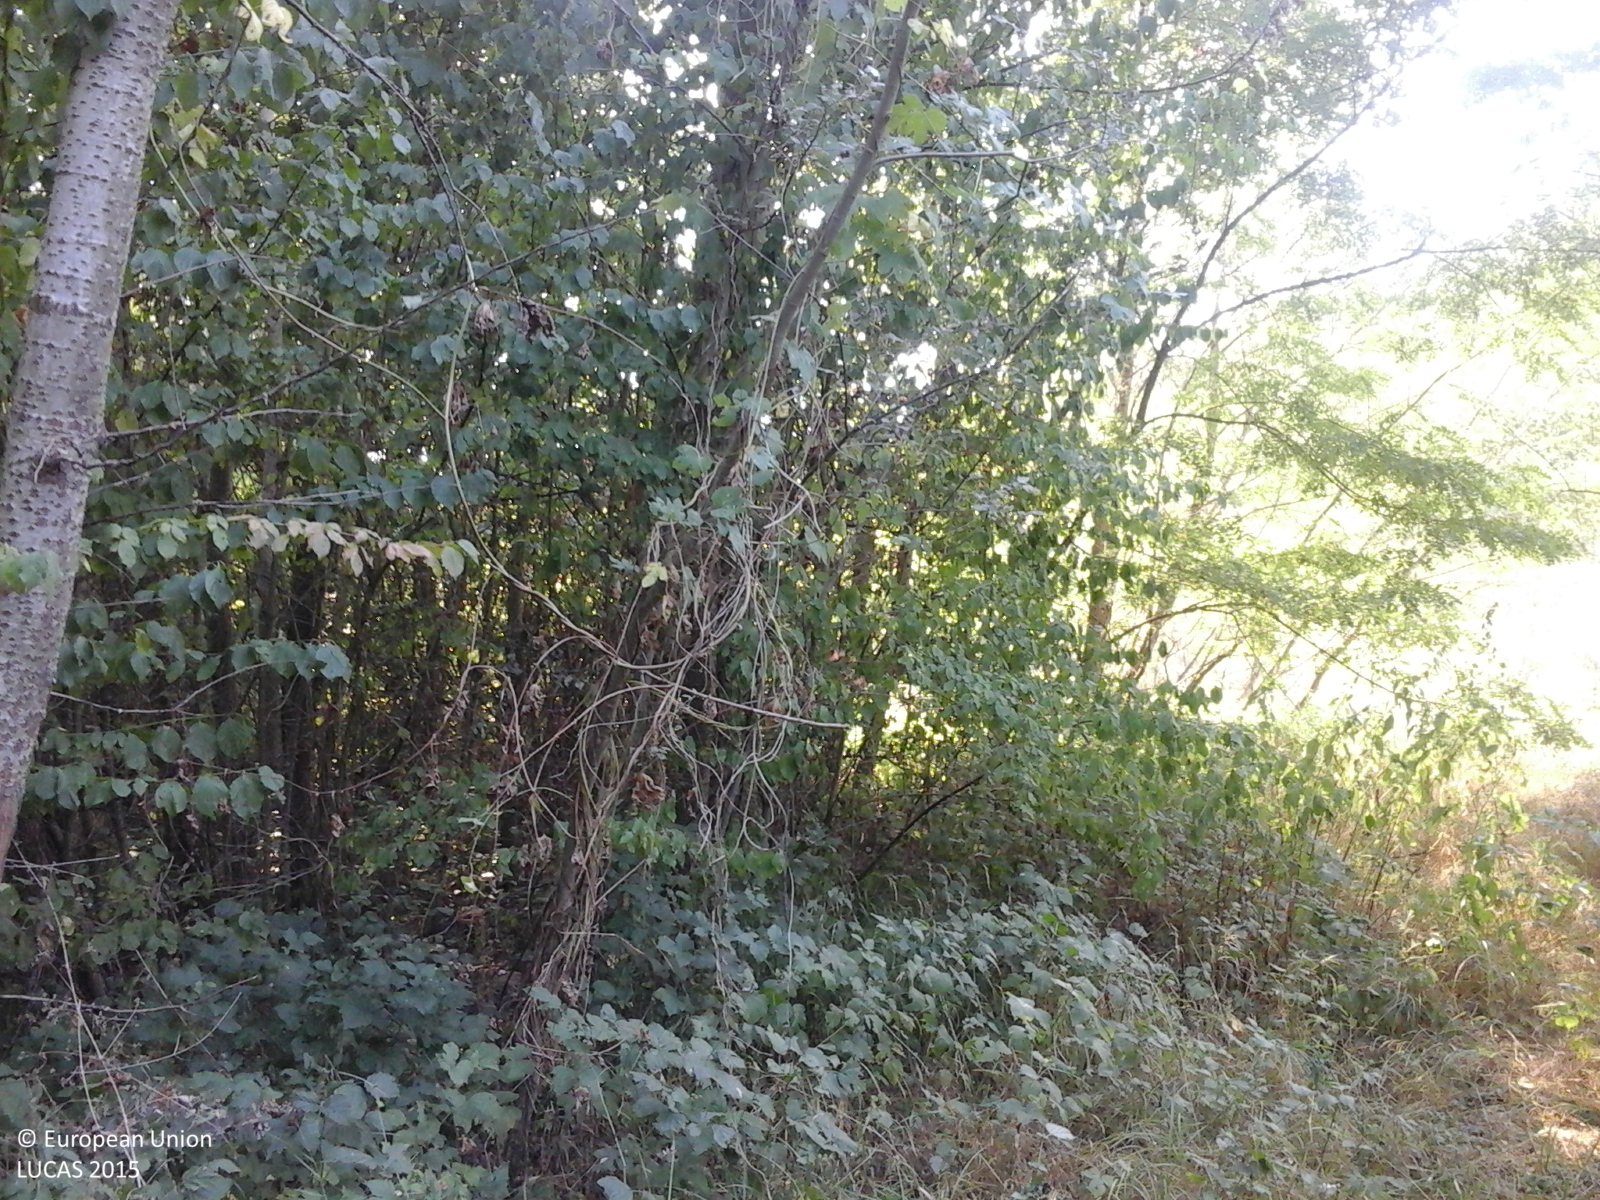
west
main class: Woodland
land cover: Broadleaved woodland
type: acidophilous oak and oak-birch forest
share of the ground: > 75 %
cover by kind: broadleaved forest trees 100 %
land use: Forestry
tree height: > 5 m
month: August
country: RO
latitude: 44.4146
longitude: 23.6307
